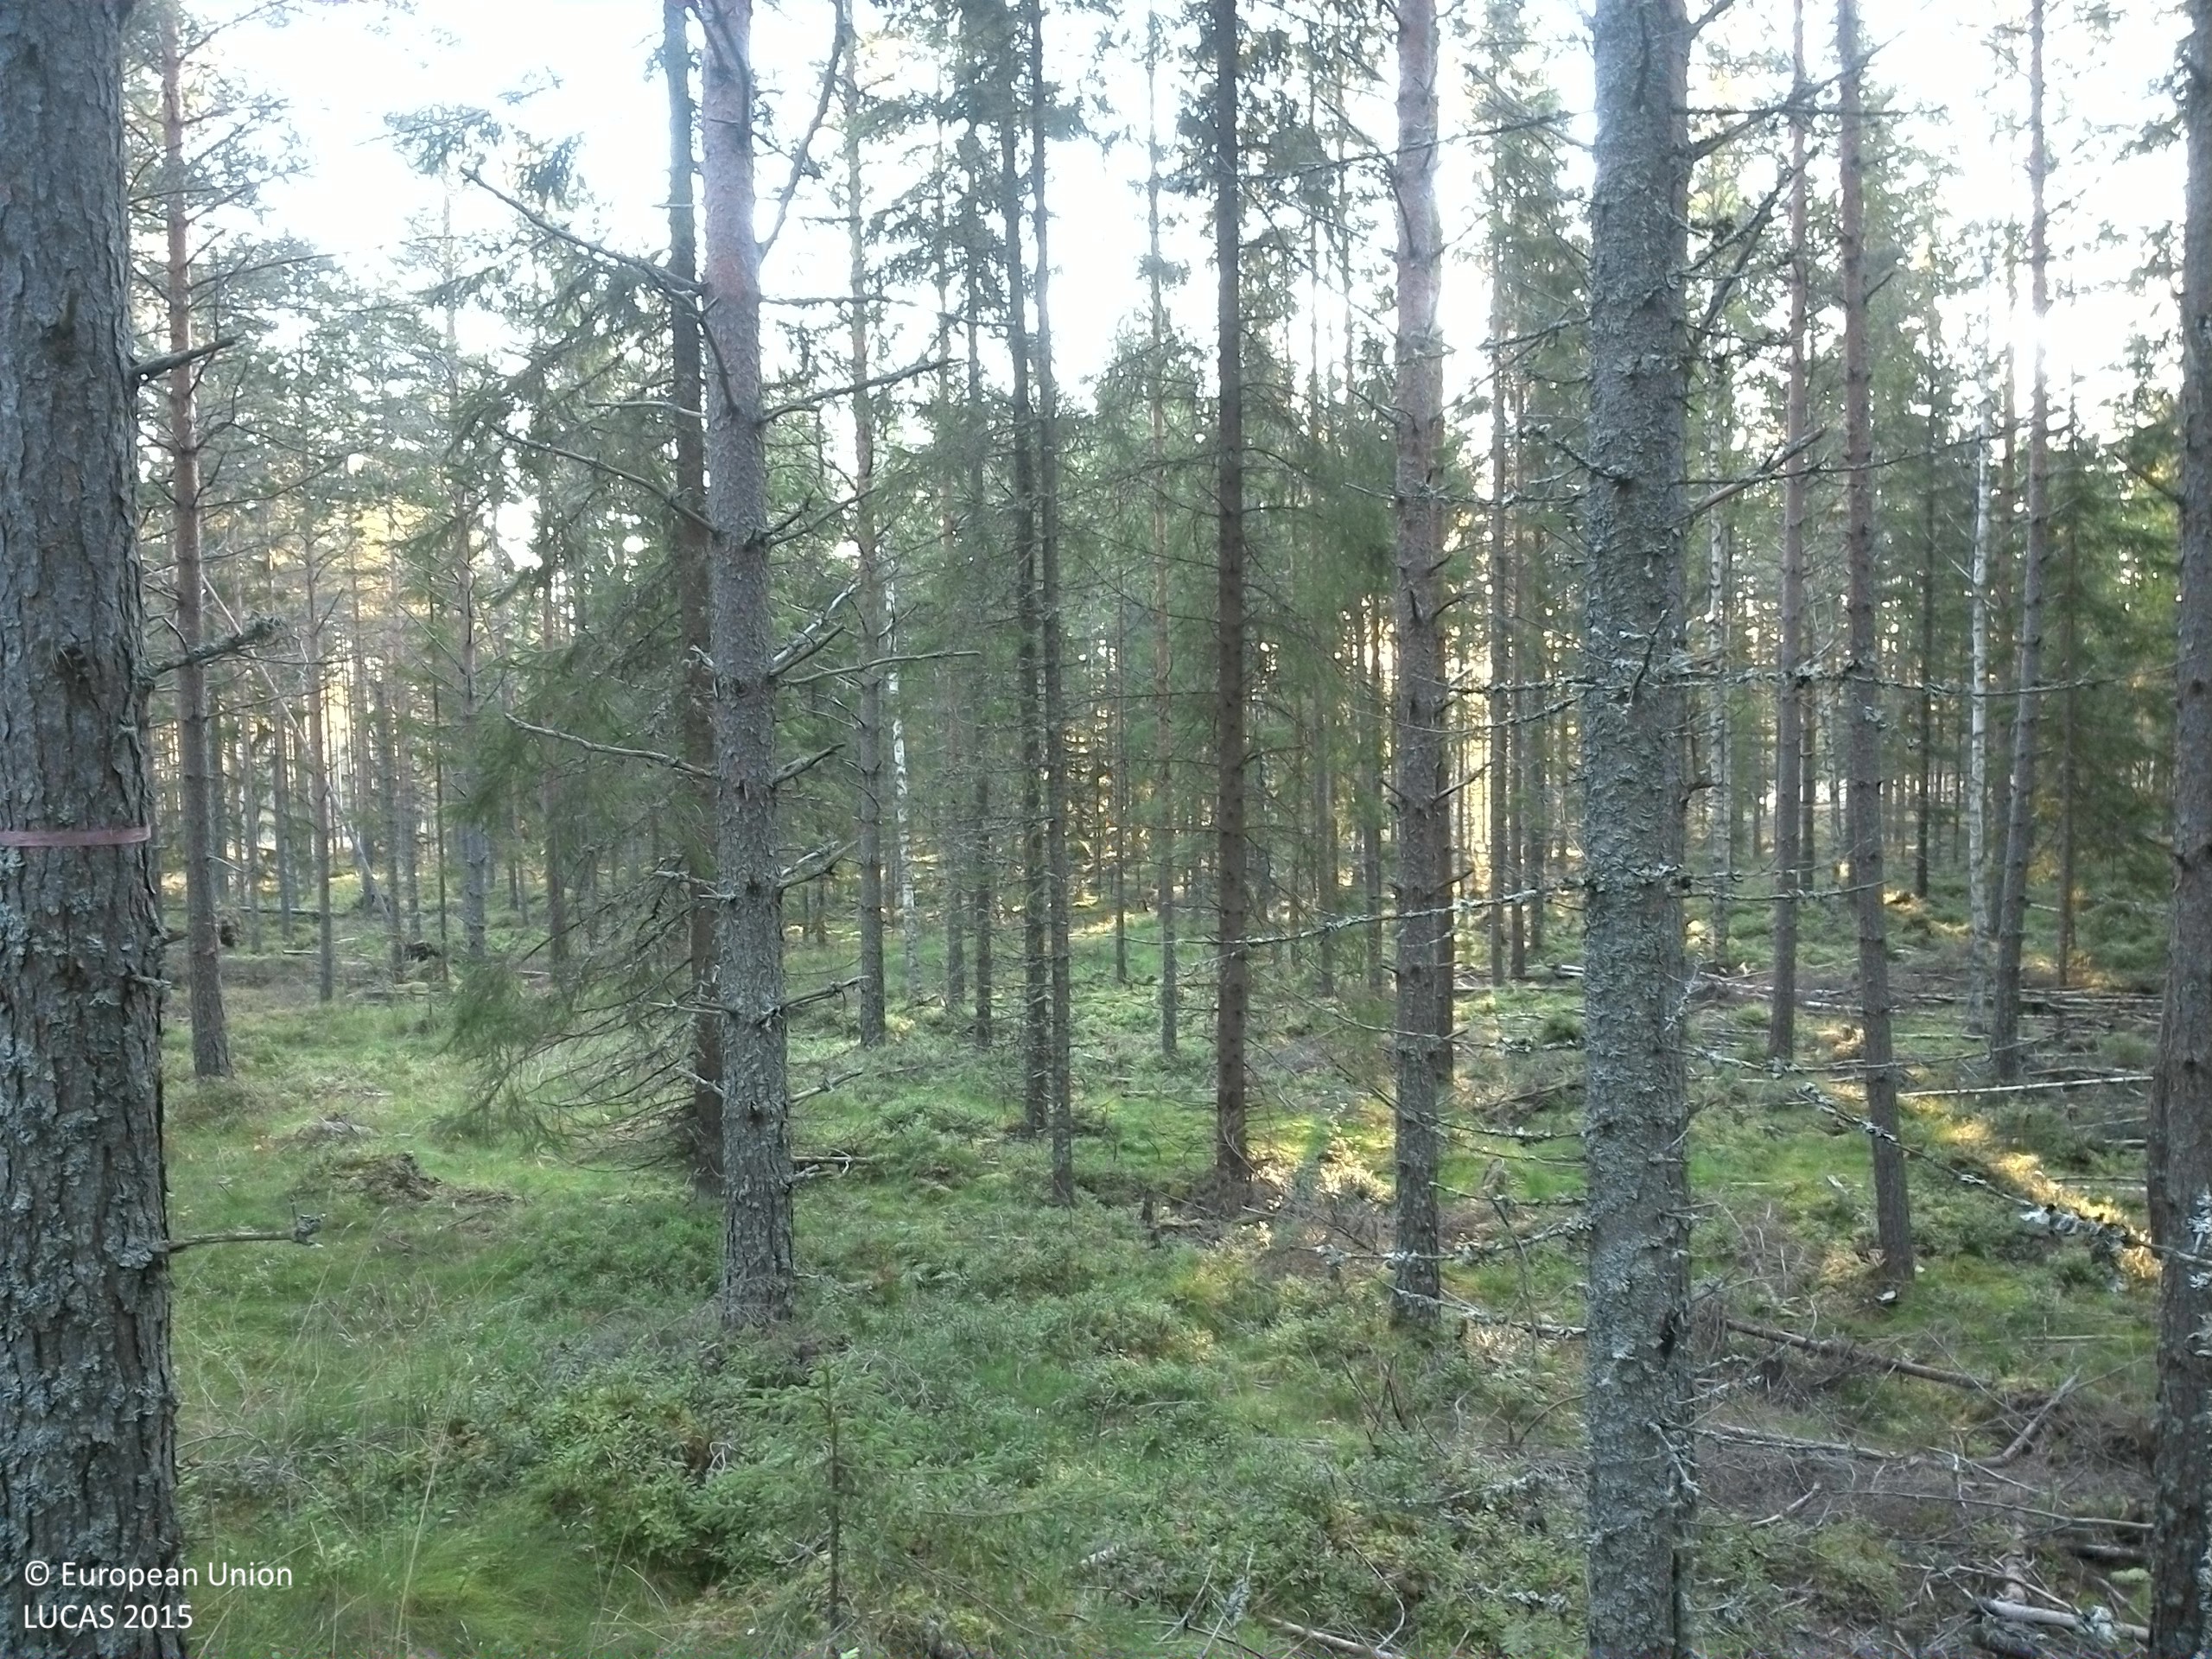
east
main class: Woodland
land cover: Pine dominated coniferous woodland
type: boreal forest
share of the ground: 50 - 75 %
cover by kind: coniferous forest trees 70 %, shrubs 25 %, lichens and mosses 5 %
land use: Forestry
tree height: > 5 m
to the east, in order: Pine dominated coniferous woodland; Tracks; Pine dominated coniferous woodland; Spruce dominated coniferous woodland; Tracks; Shrubland without tree cover; Electric lines; Shrubland without tree cover; Spruce dominated coniferous woodland; Spruce dominated mixed woodland; Ditches and canals; Spruce dominated mixed woodland; Pine dominated coniferous woodland
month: September
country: SE
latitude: 59.8865
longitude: 13.4399
